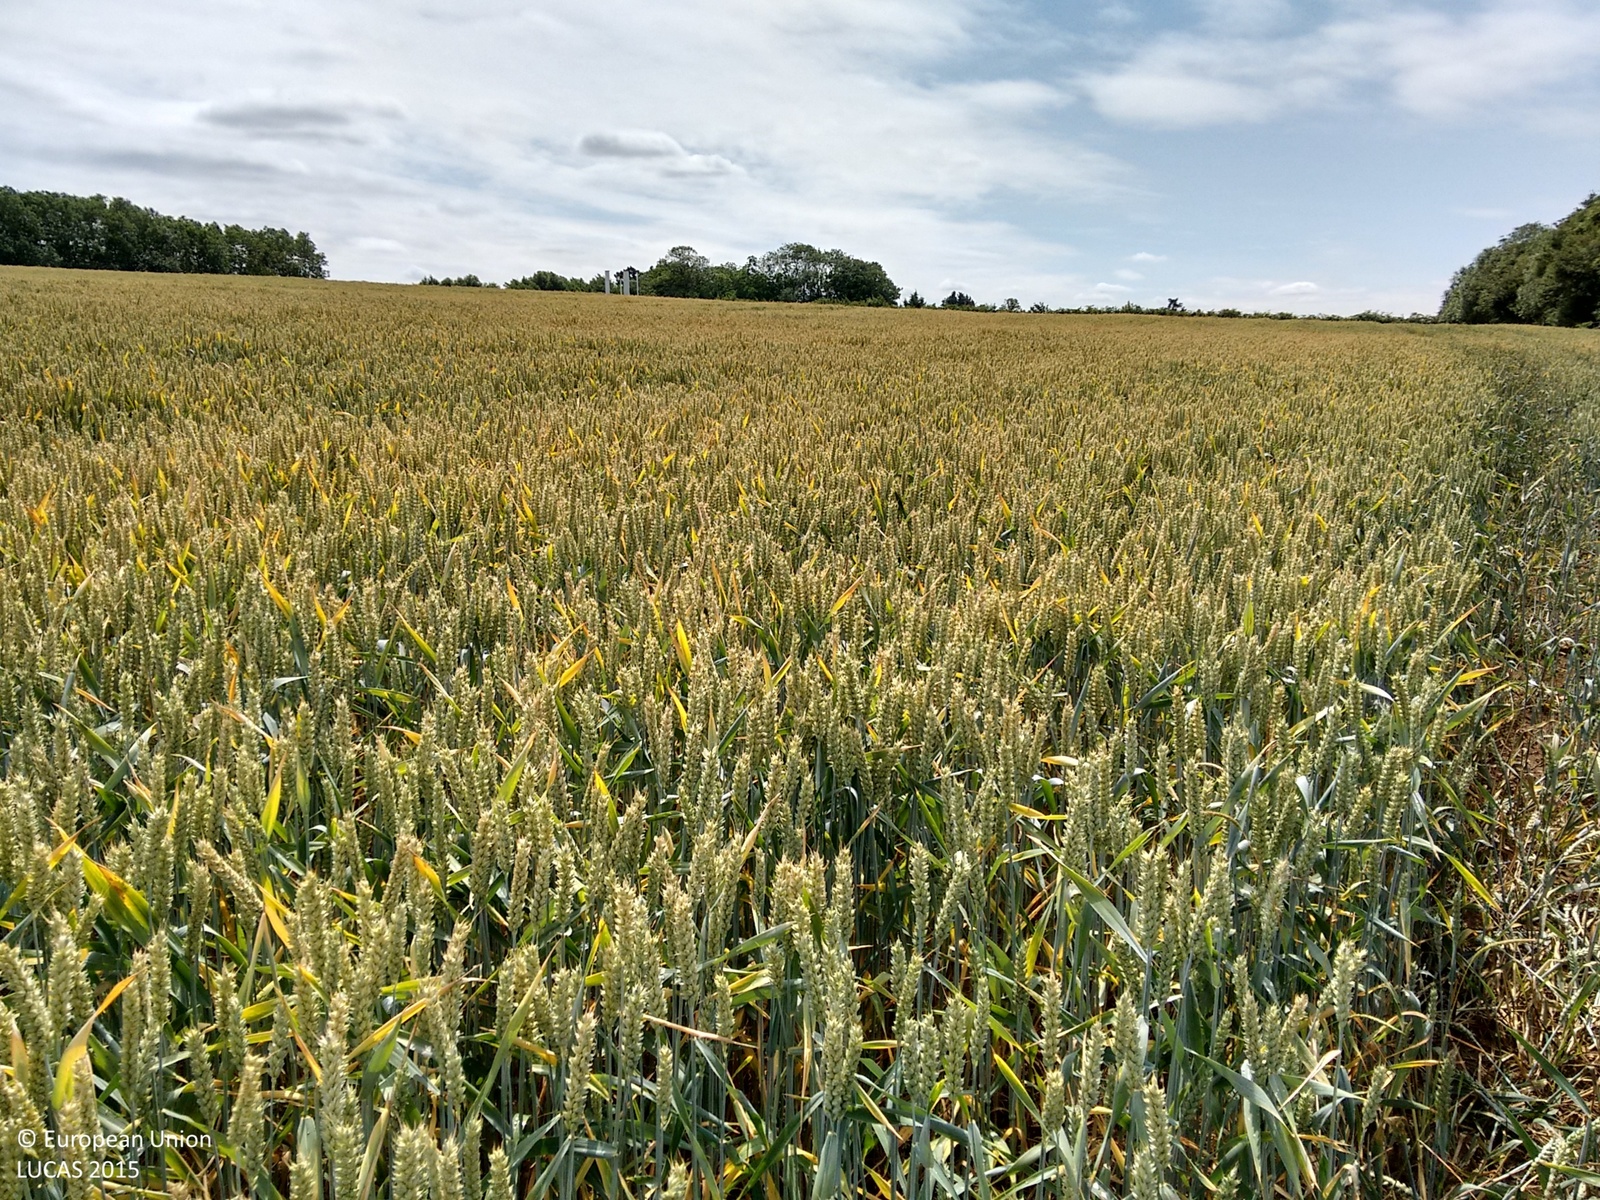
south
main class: Cropland
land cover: Common wheat
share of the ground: > 75 %
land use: Agriculture (excluding fallow land and kitchen gardens)
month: July
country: GB
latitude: 52.6320
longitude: -0.5436
